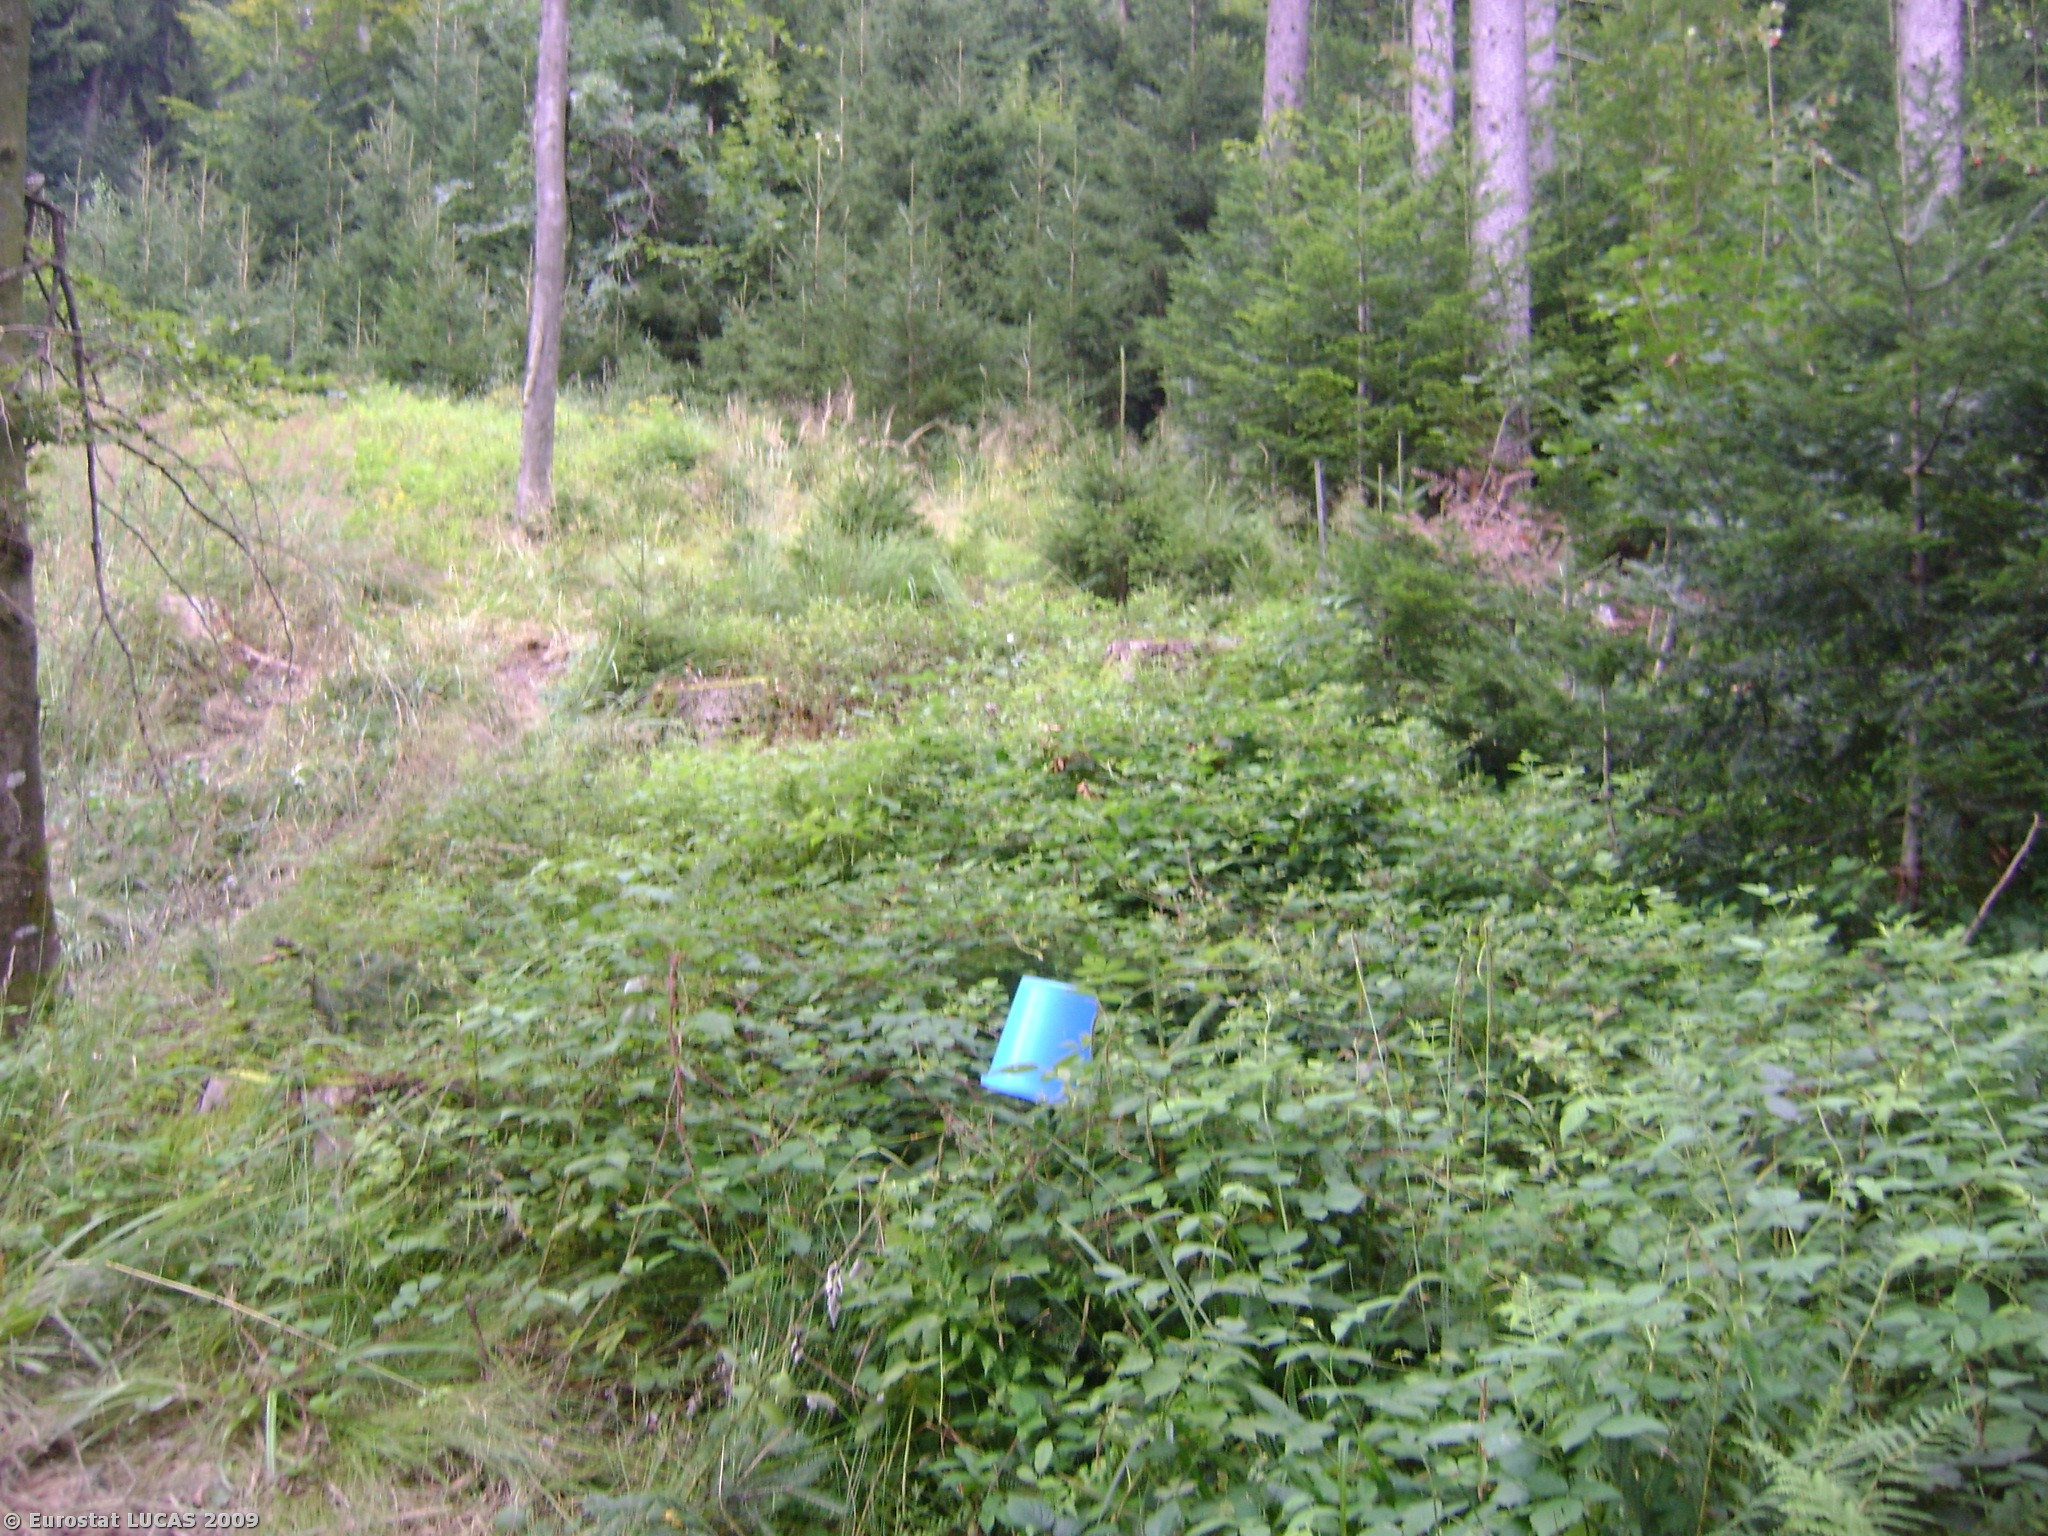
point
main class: Shrubland
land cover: Shrubland with sparse tree cover
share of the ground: > 75 %
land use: Forestry
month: August
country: AT
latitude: 47.8704
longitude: 13.2207
